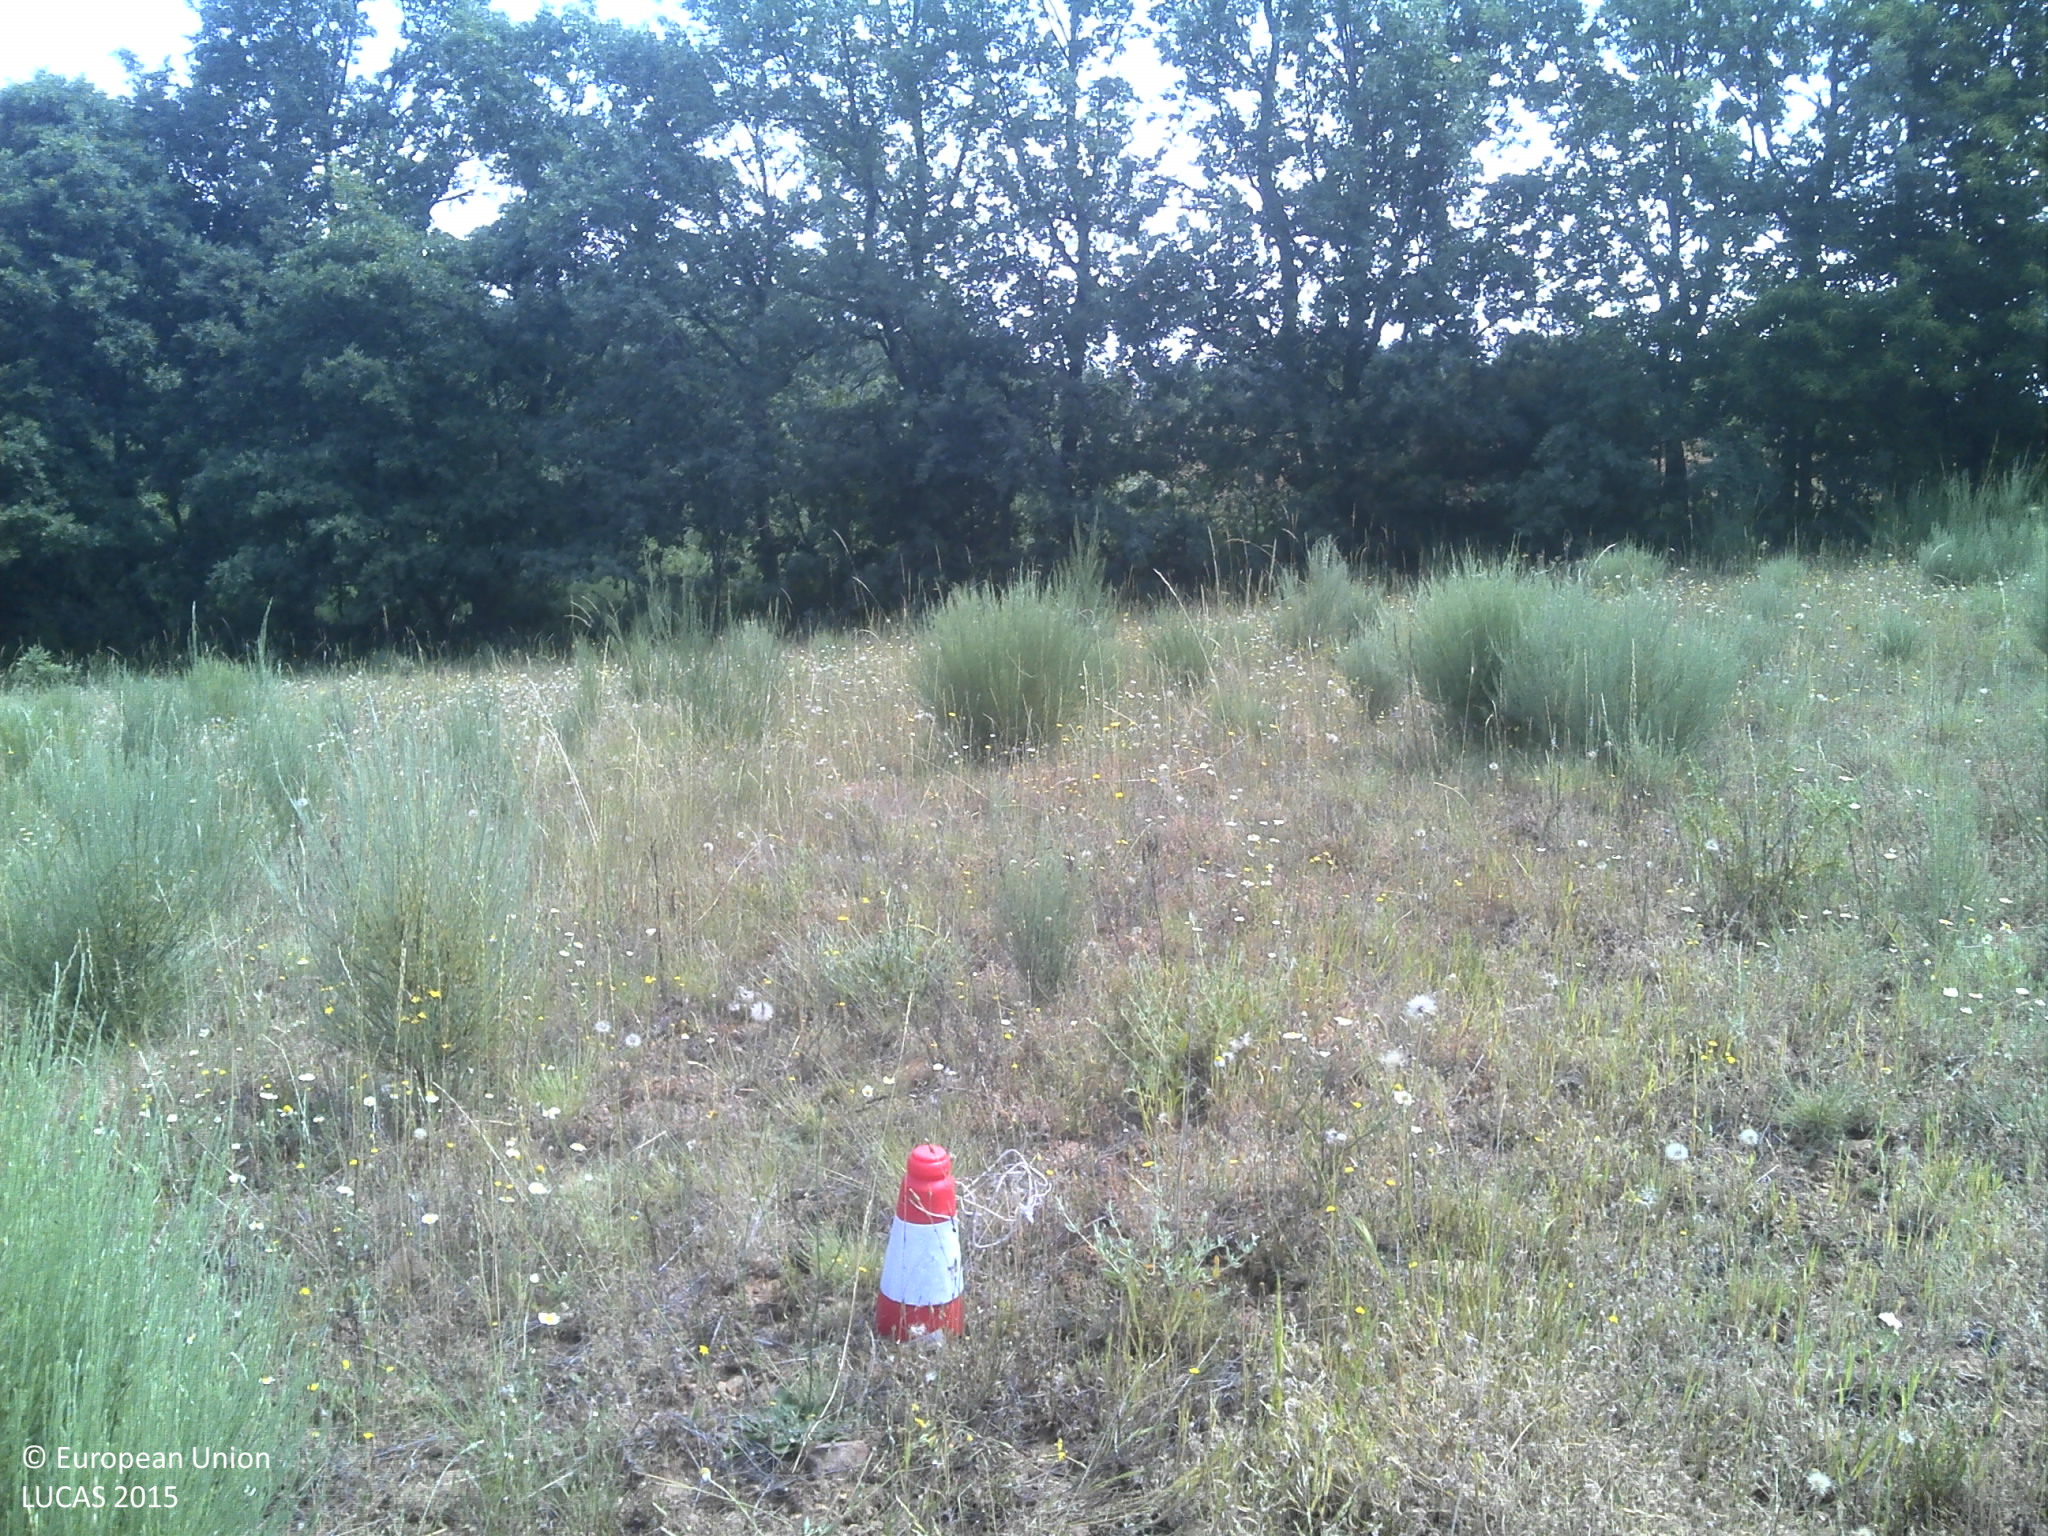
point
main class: Grassland
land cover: Grassland without tree/shrub cover
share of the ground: 25 - 50 %
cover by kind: herbaceous plants 50 %, unconsolidated bare surface 40 %, shrubs 5 %
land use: Agriculture (excluding fallow land and kitchen gardens)
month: June
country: PT
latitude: 40.3446
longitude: -6.9657
